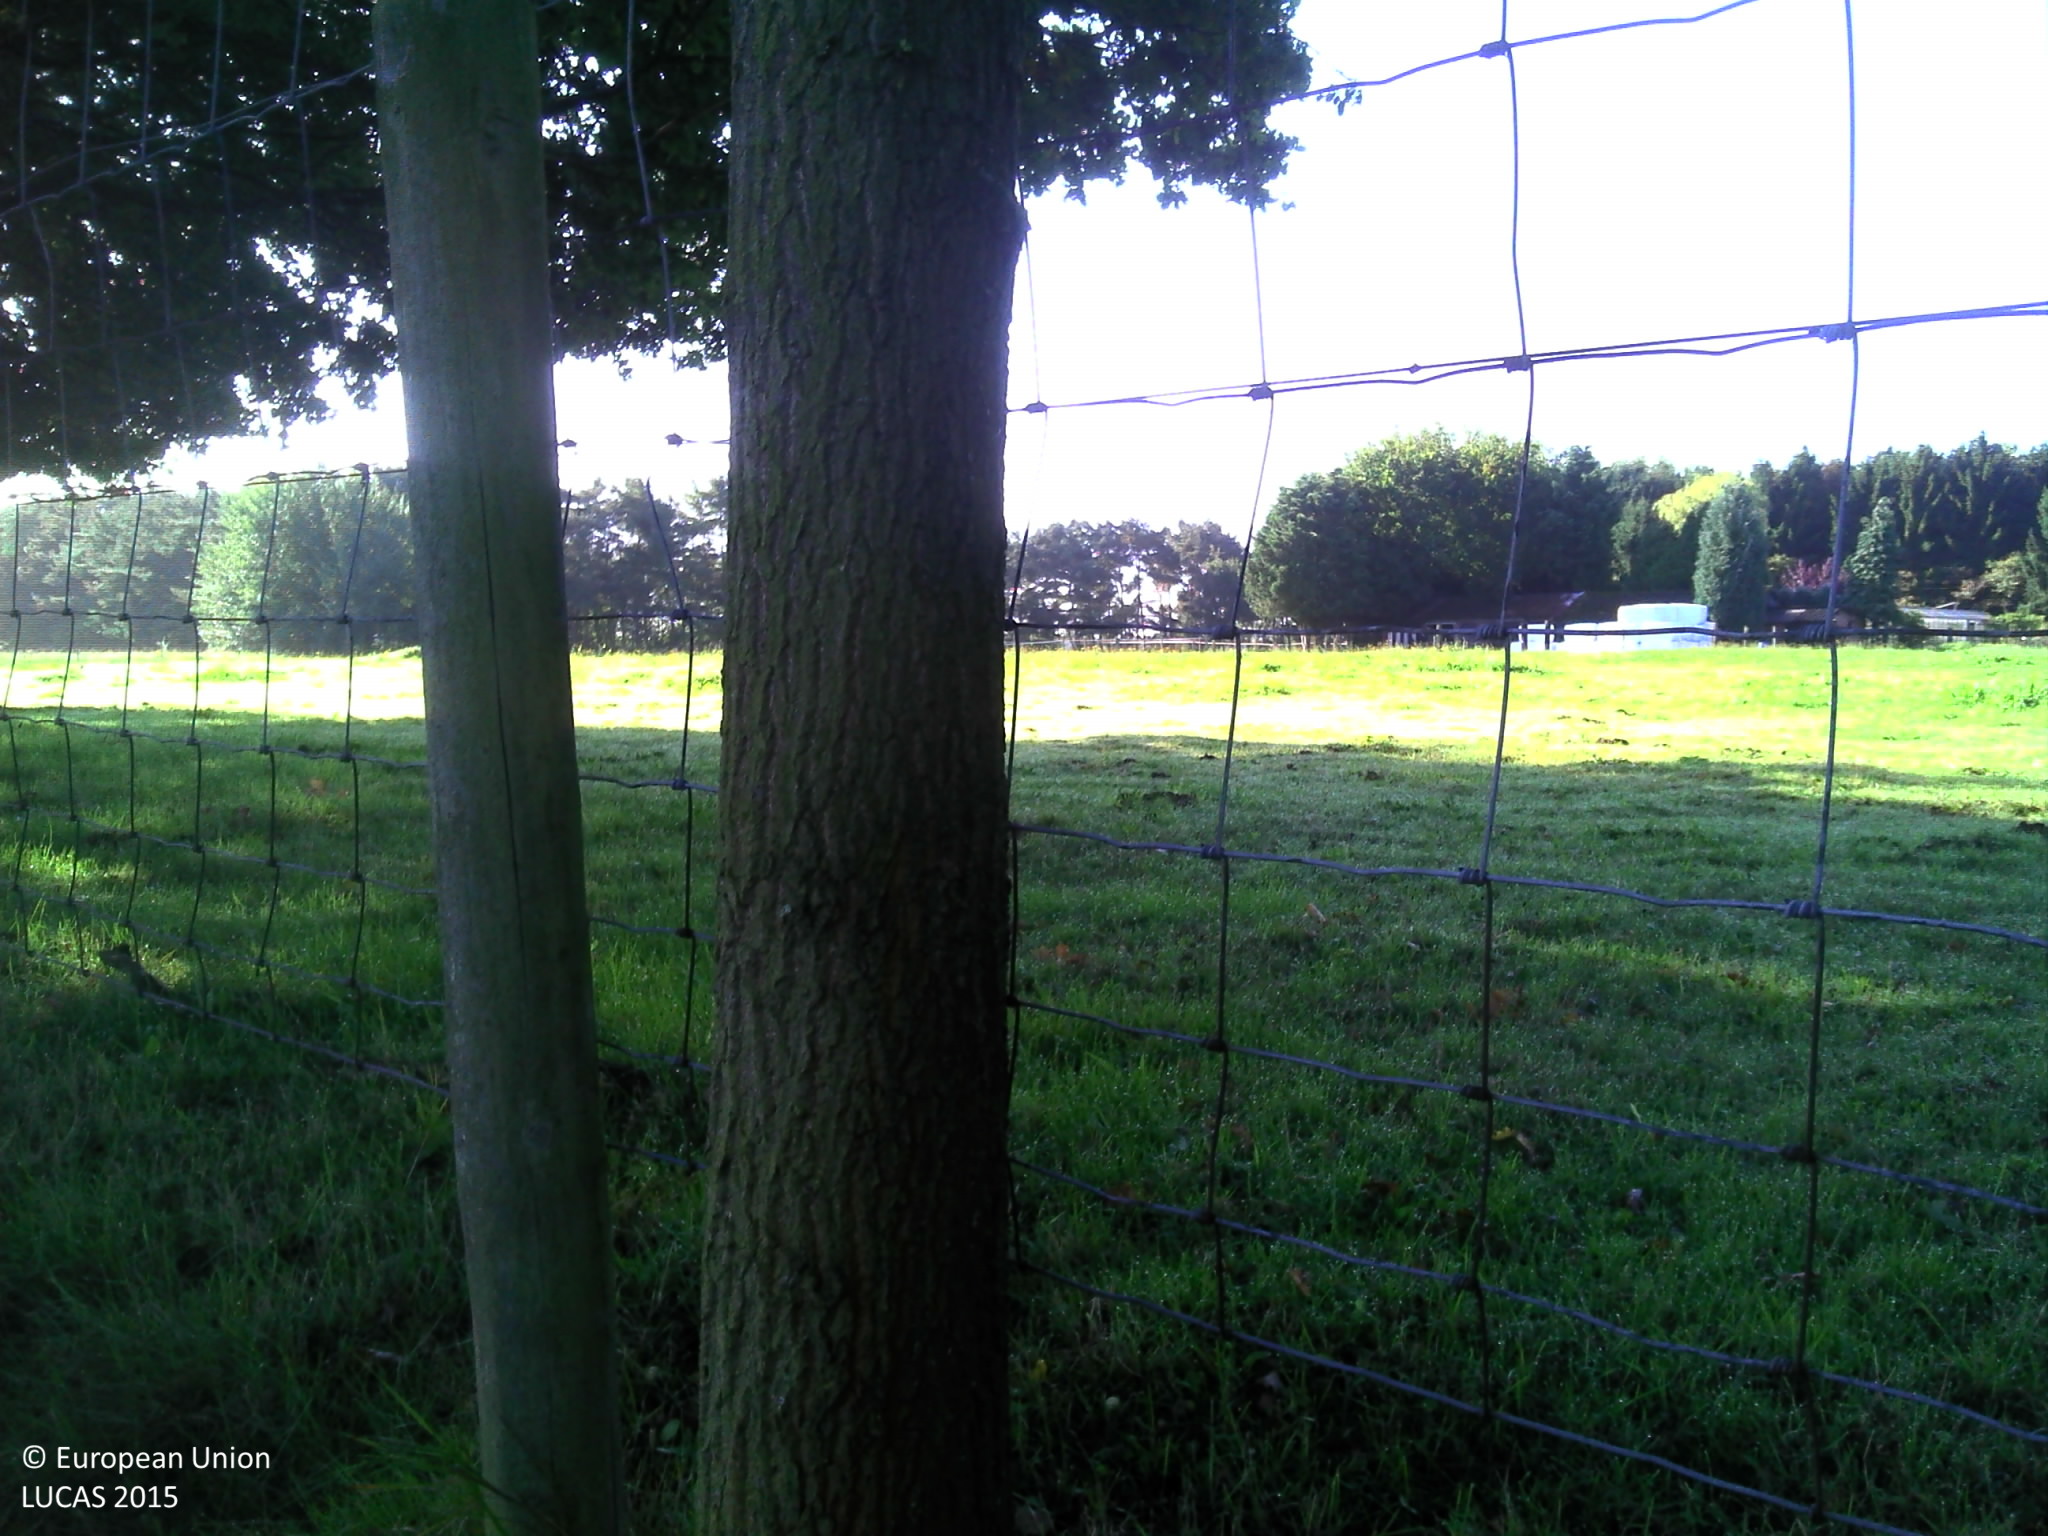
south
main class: Grassland
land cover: Grassland without tree/shrub cover
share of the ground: > 75 %
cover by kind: herbaceous plants 100 %
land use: Agriculture (excluding fallow land and kitchen gardens)
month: September
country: BE
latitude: 51.0815
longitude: 4.5572
